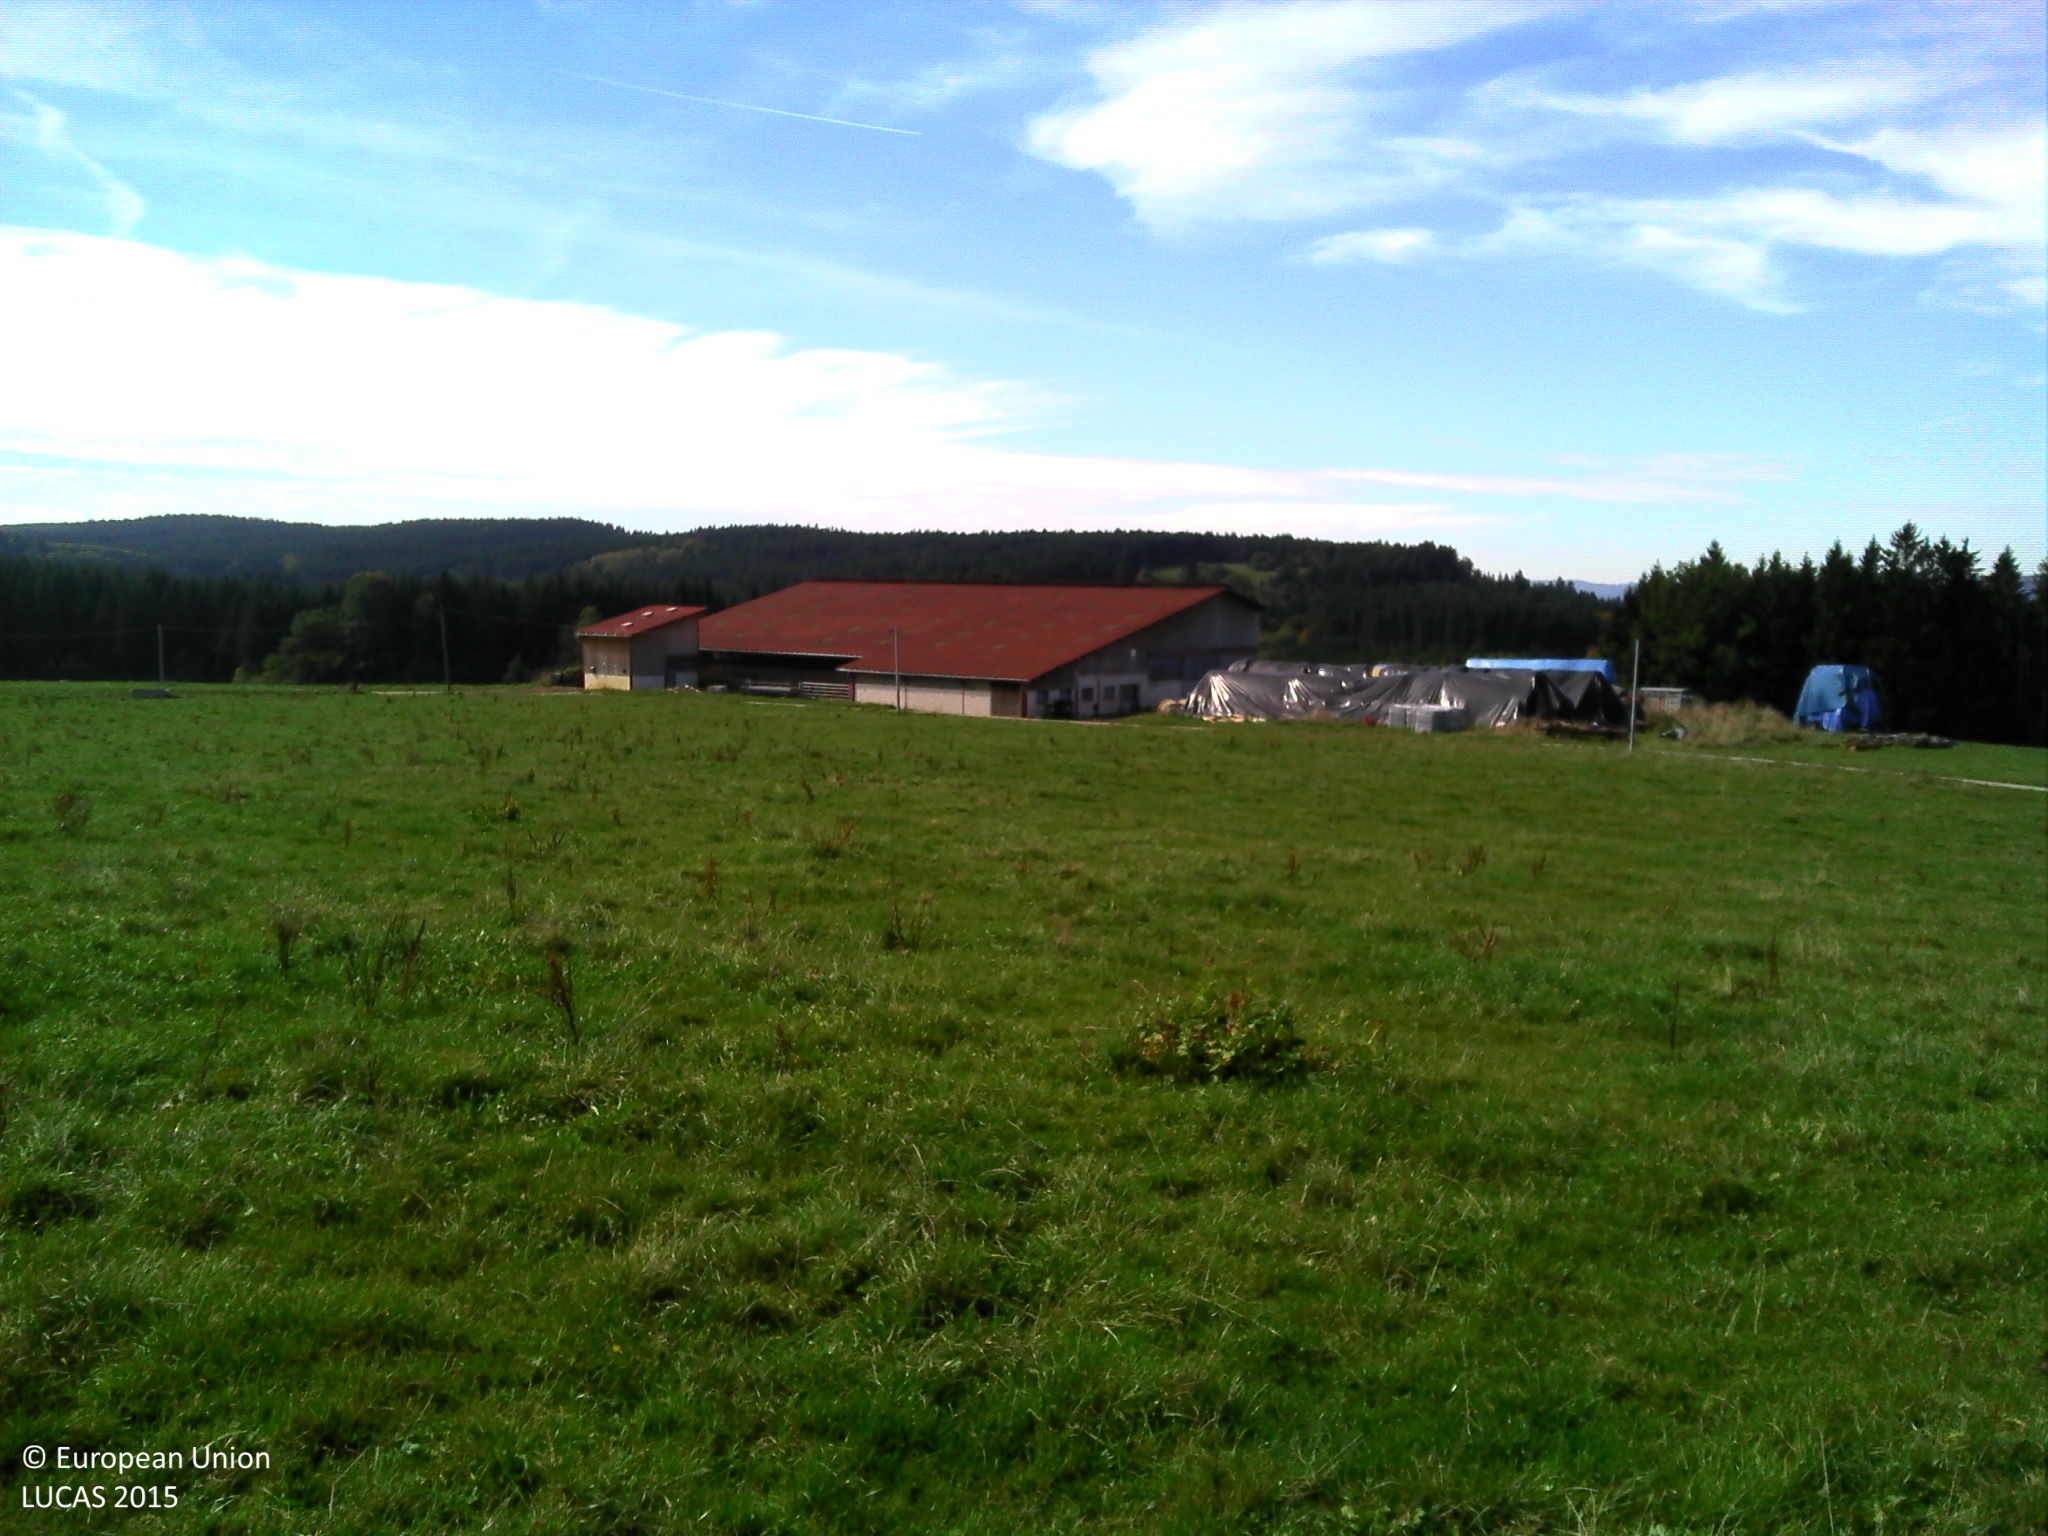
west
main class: Grassland
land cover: Grassland without tree/shrub cover
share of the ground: > 75 %
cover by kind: herbaceous plants 100 %
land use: Agriculture (excluding fallow land and kitchen gardens)
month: October
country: FR
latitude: 46.9914
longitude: 6.3337
